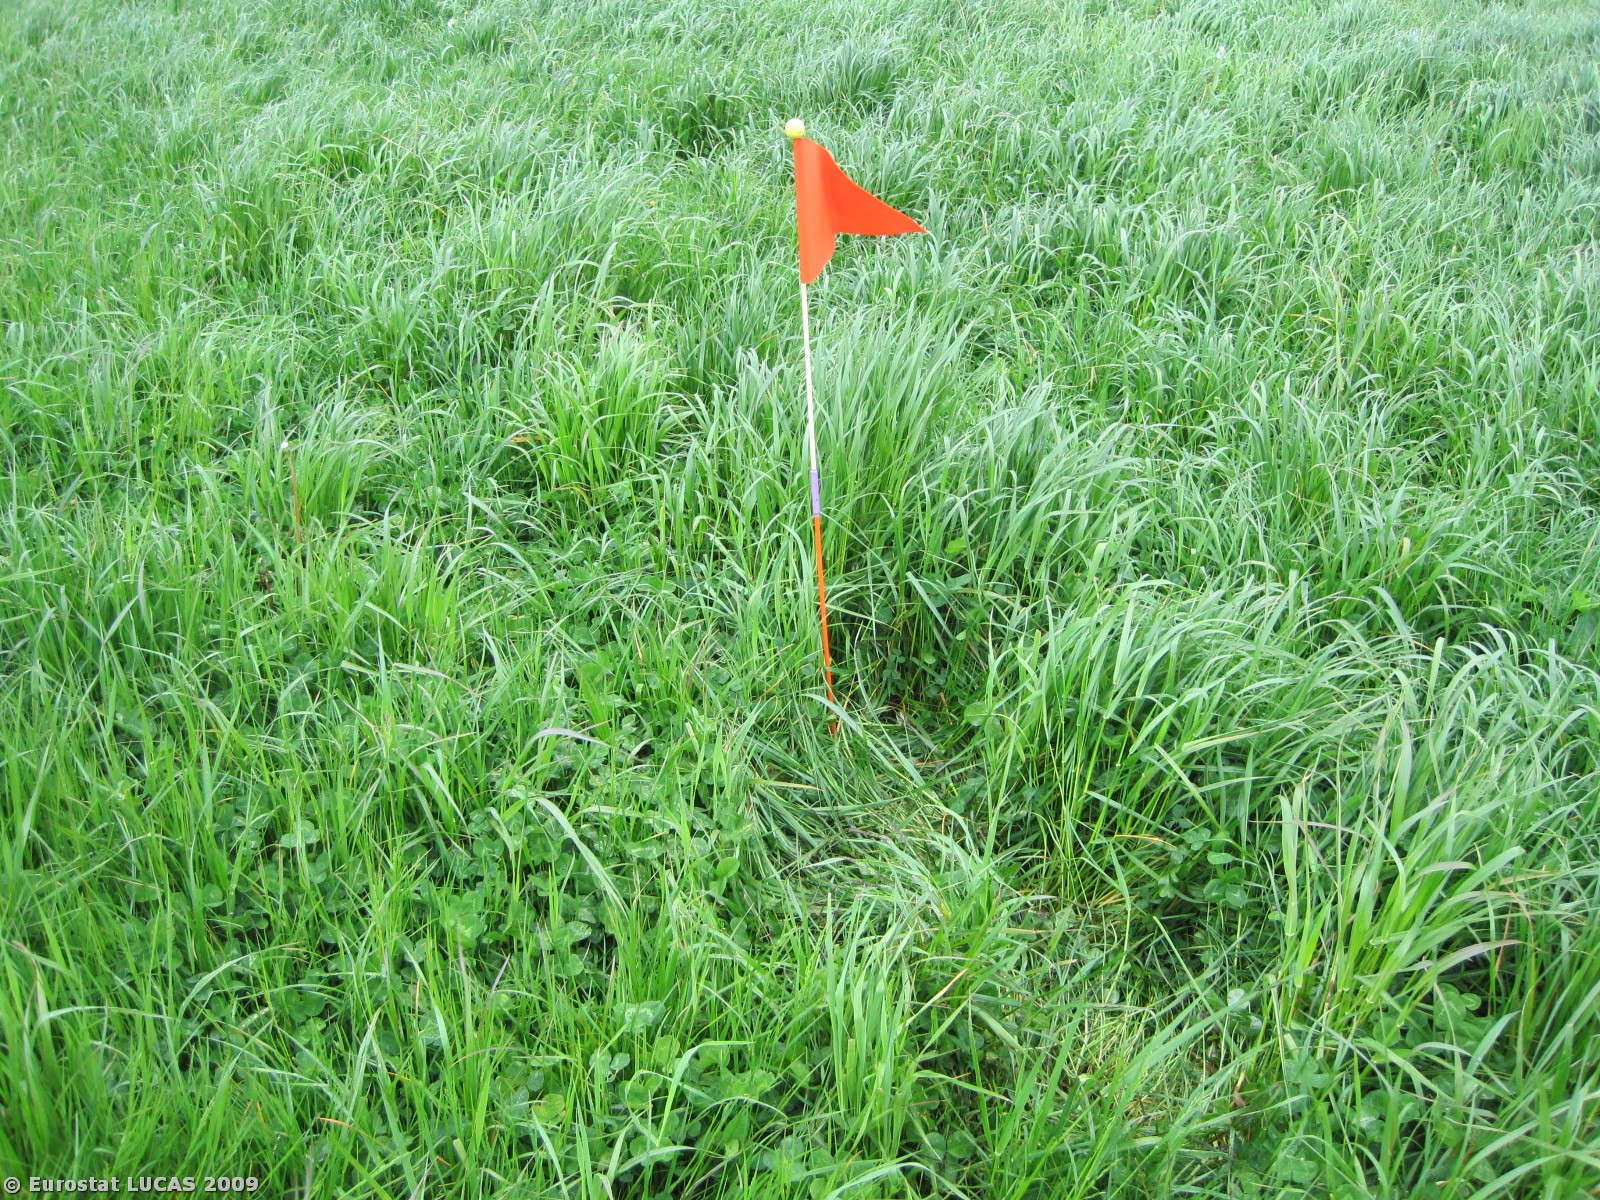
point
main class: Grassland
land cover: Grassland without tree/shrub cover
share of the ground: > 75 %
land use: Agriculture (excluding fallow land and kitchen gardens)
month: May
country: DK
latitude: 56.8345
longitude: 9.6890
